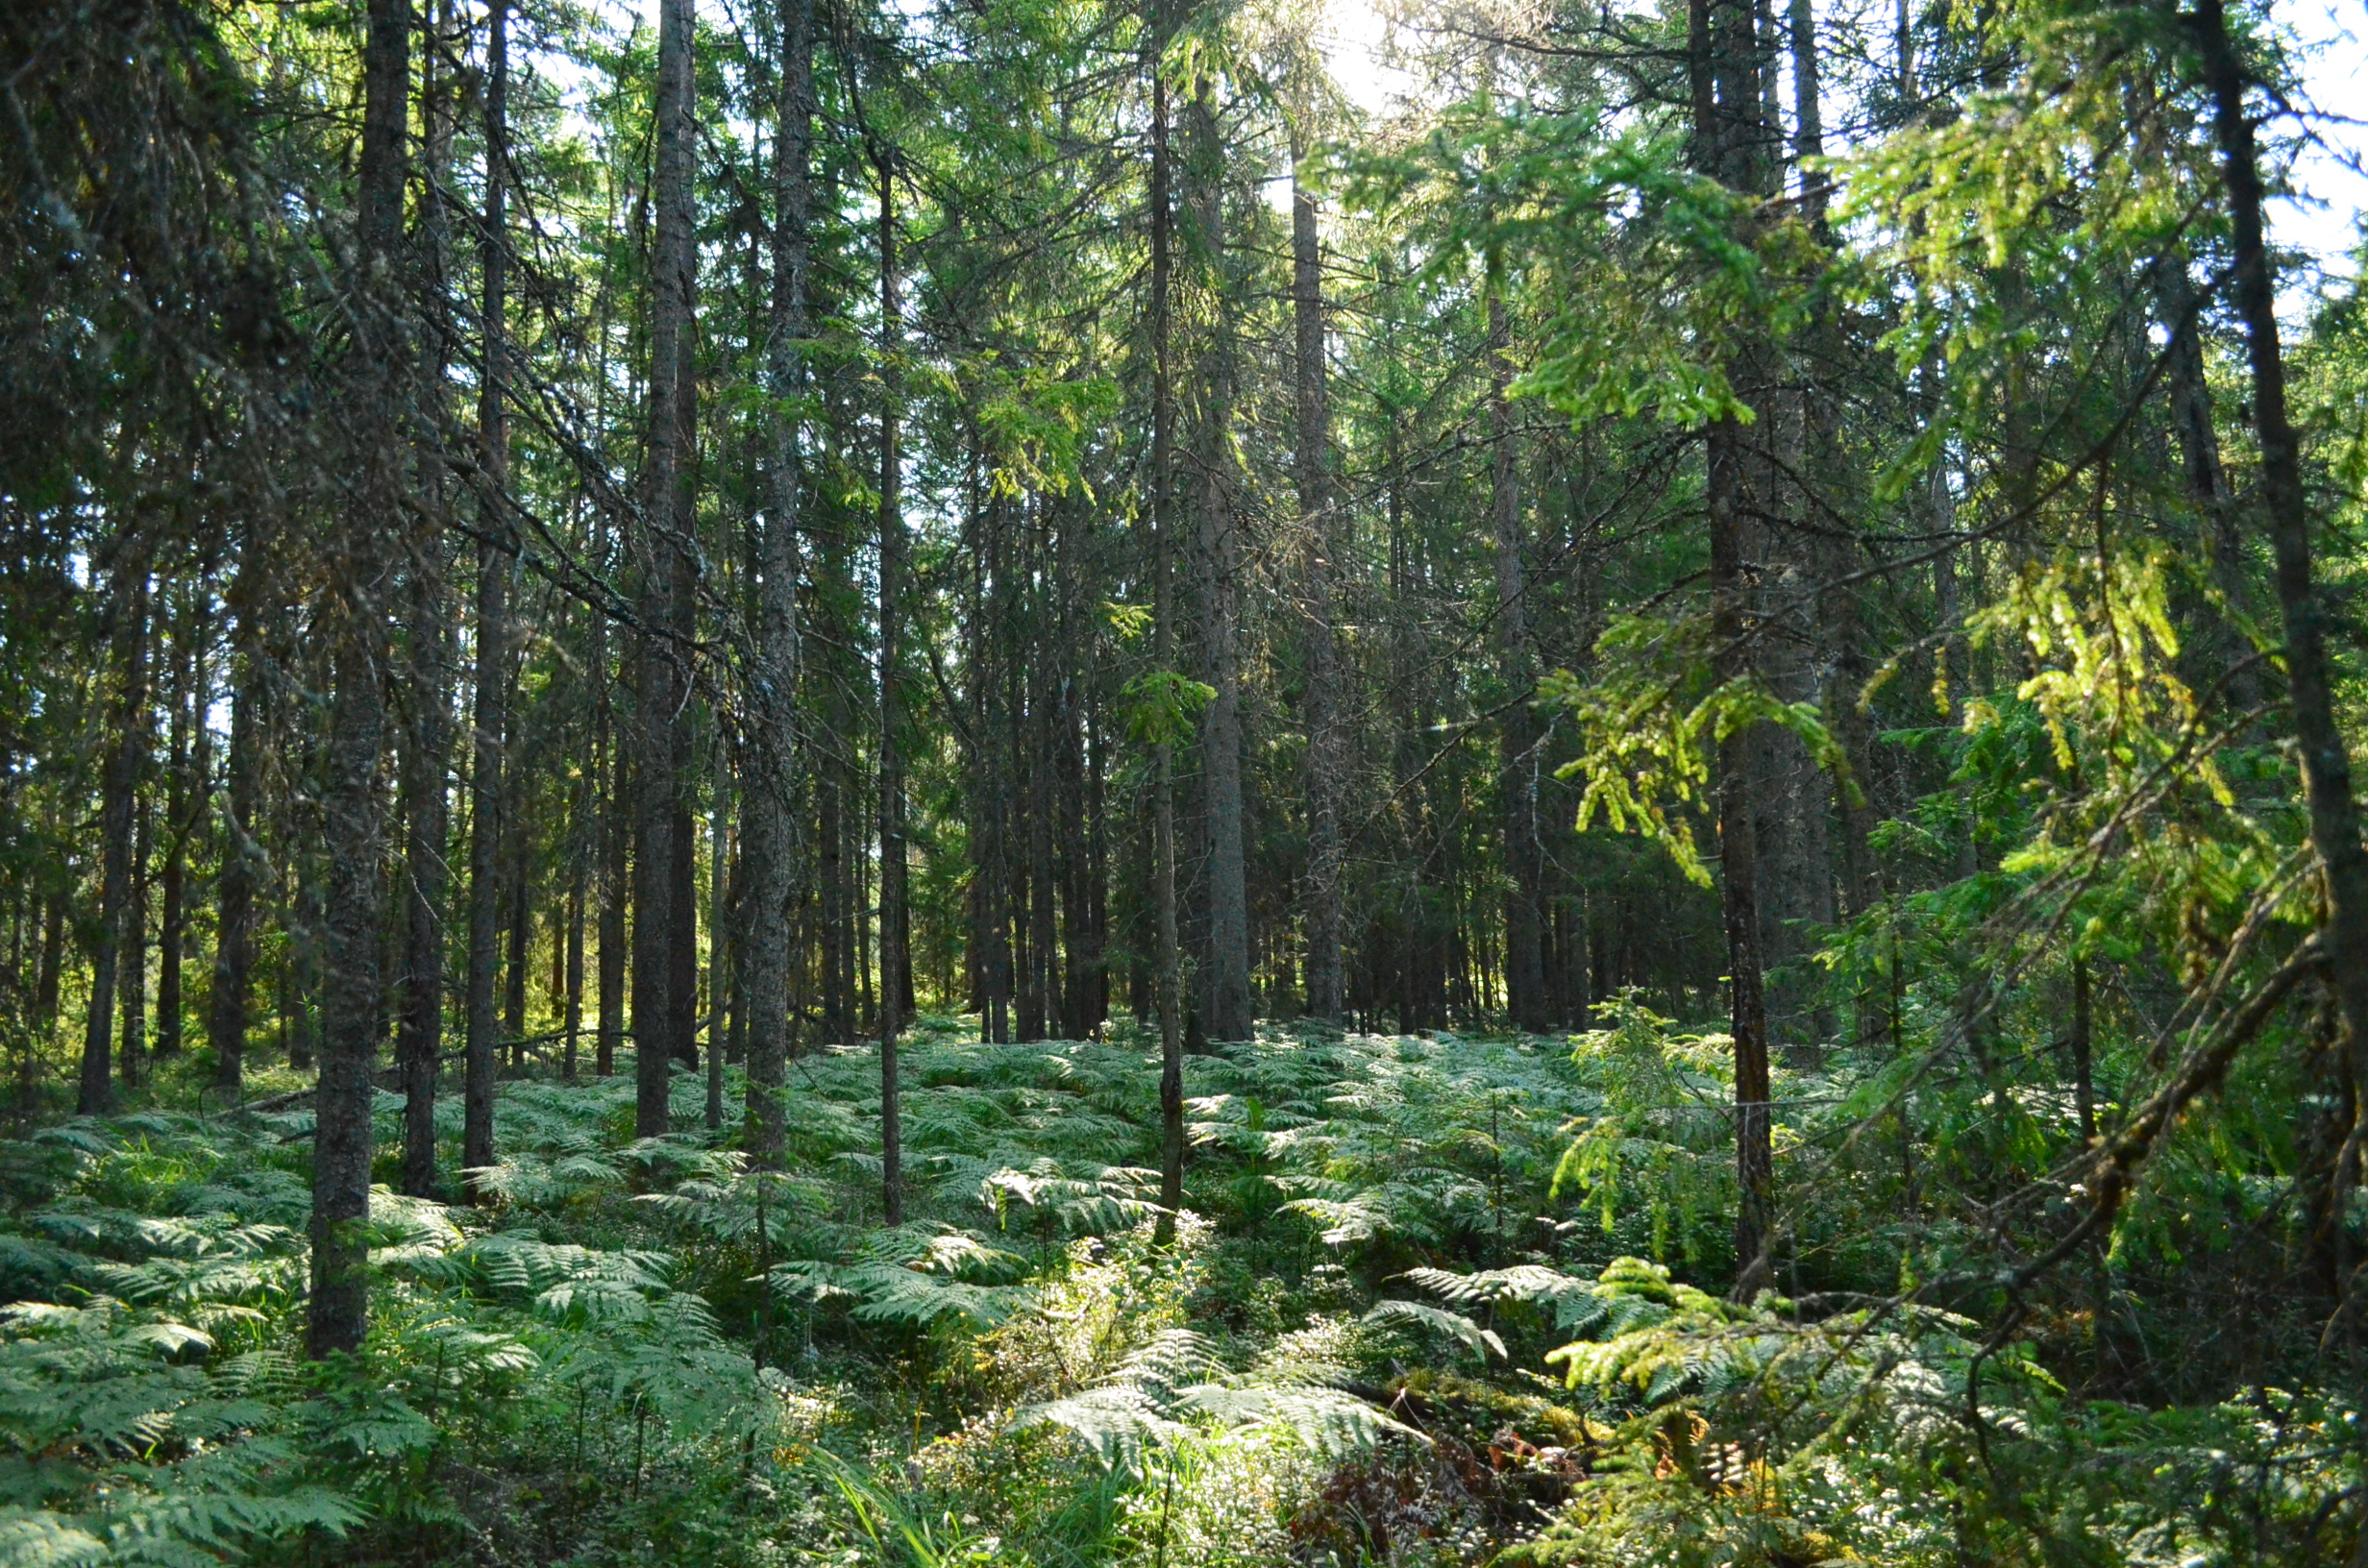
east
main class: Woodland
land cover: Spruce dominated coniferous woodland
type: hemiboreal forest and nemoral coniferous forest and mixed broadleaved-coniferous forest
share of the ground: 50 - 75 %
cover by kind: coniferous forest trees 60 %, shrubs 15 %, herbaceous plants 10 %, lichens and mosses 10 %, broadleaved forest trees 5 %
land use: Forestry
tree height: > 5 m
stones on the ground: < 10 %
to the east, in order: Spruce dominated coniferous woodland; Pine dominated coniferous woodland
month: August
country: LV
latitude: 57.6375
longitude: 22.2592
